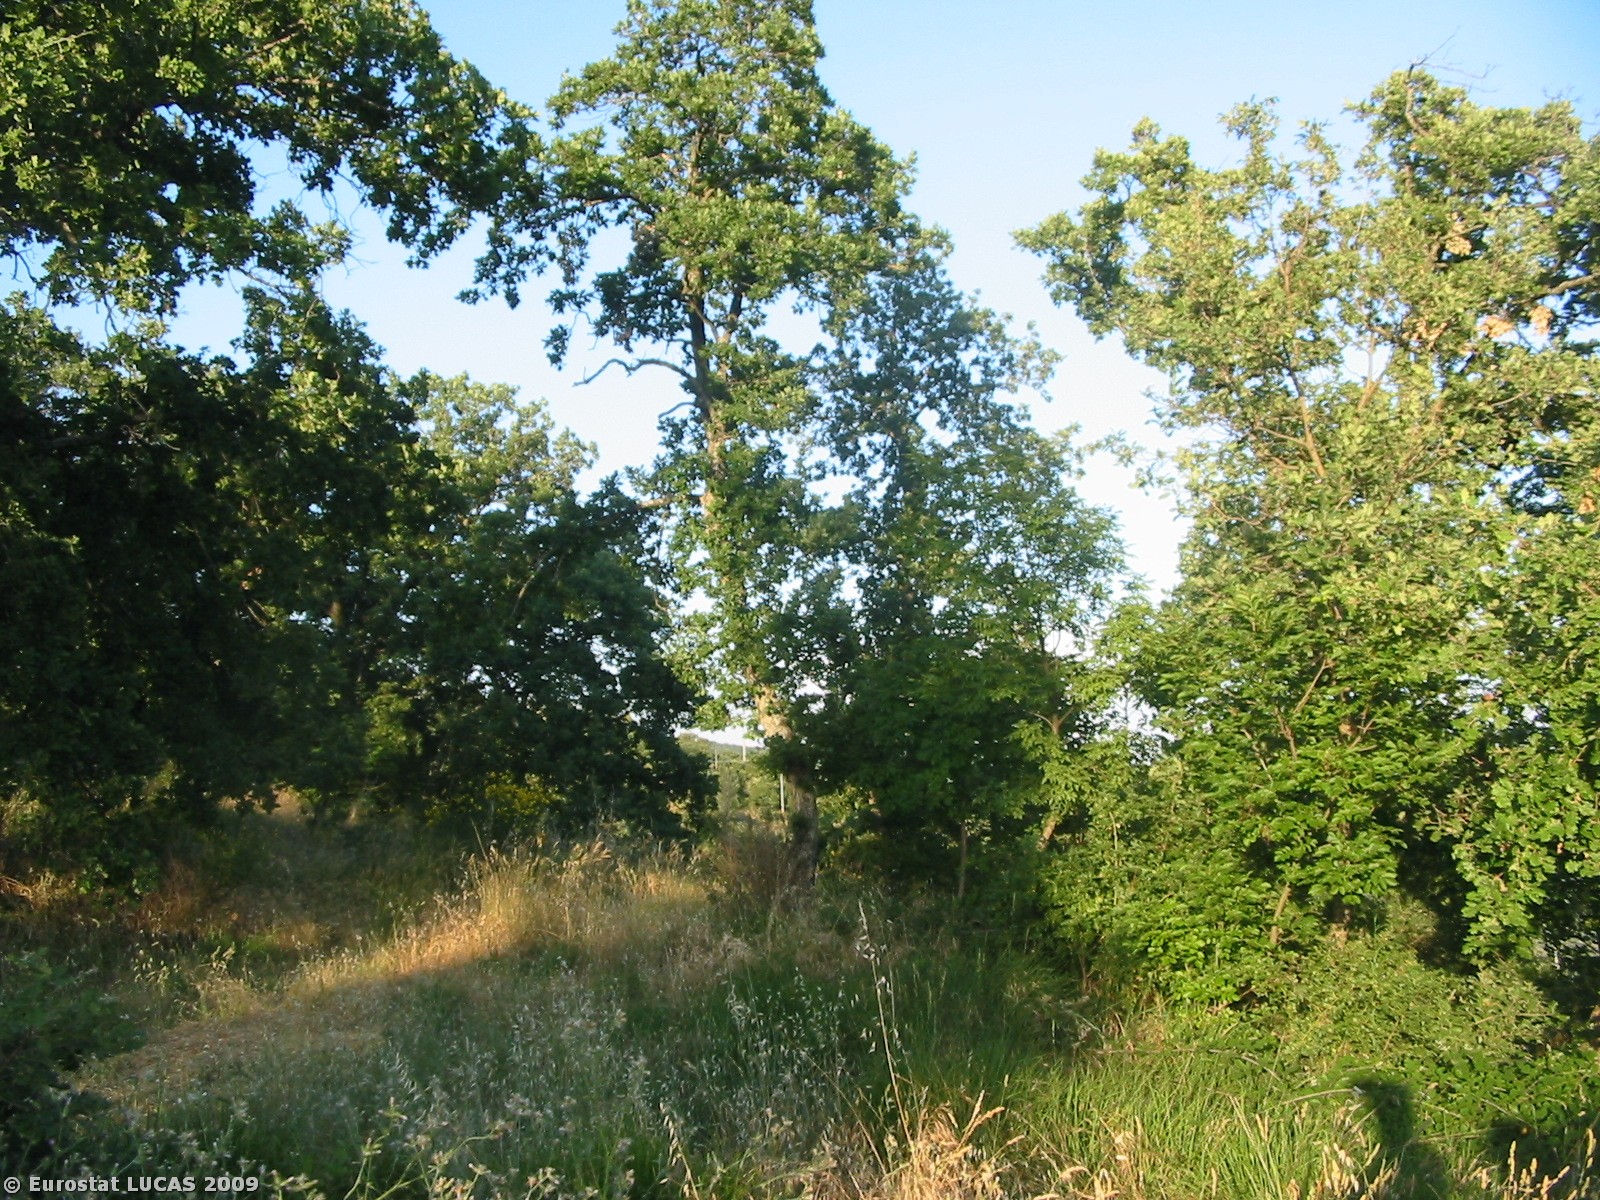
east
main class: Shrubland
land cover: Shrubland with sparse tree cover
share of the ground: > 75 %
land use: Unused
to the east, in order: Shrubland with sparse tree cover; Olive groves; Grassland with sparse tree/shrub cover; Shrubland with sparse tree cover
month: June
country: IT
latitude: 43.2844
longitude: 12.0031
